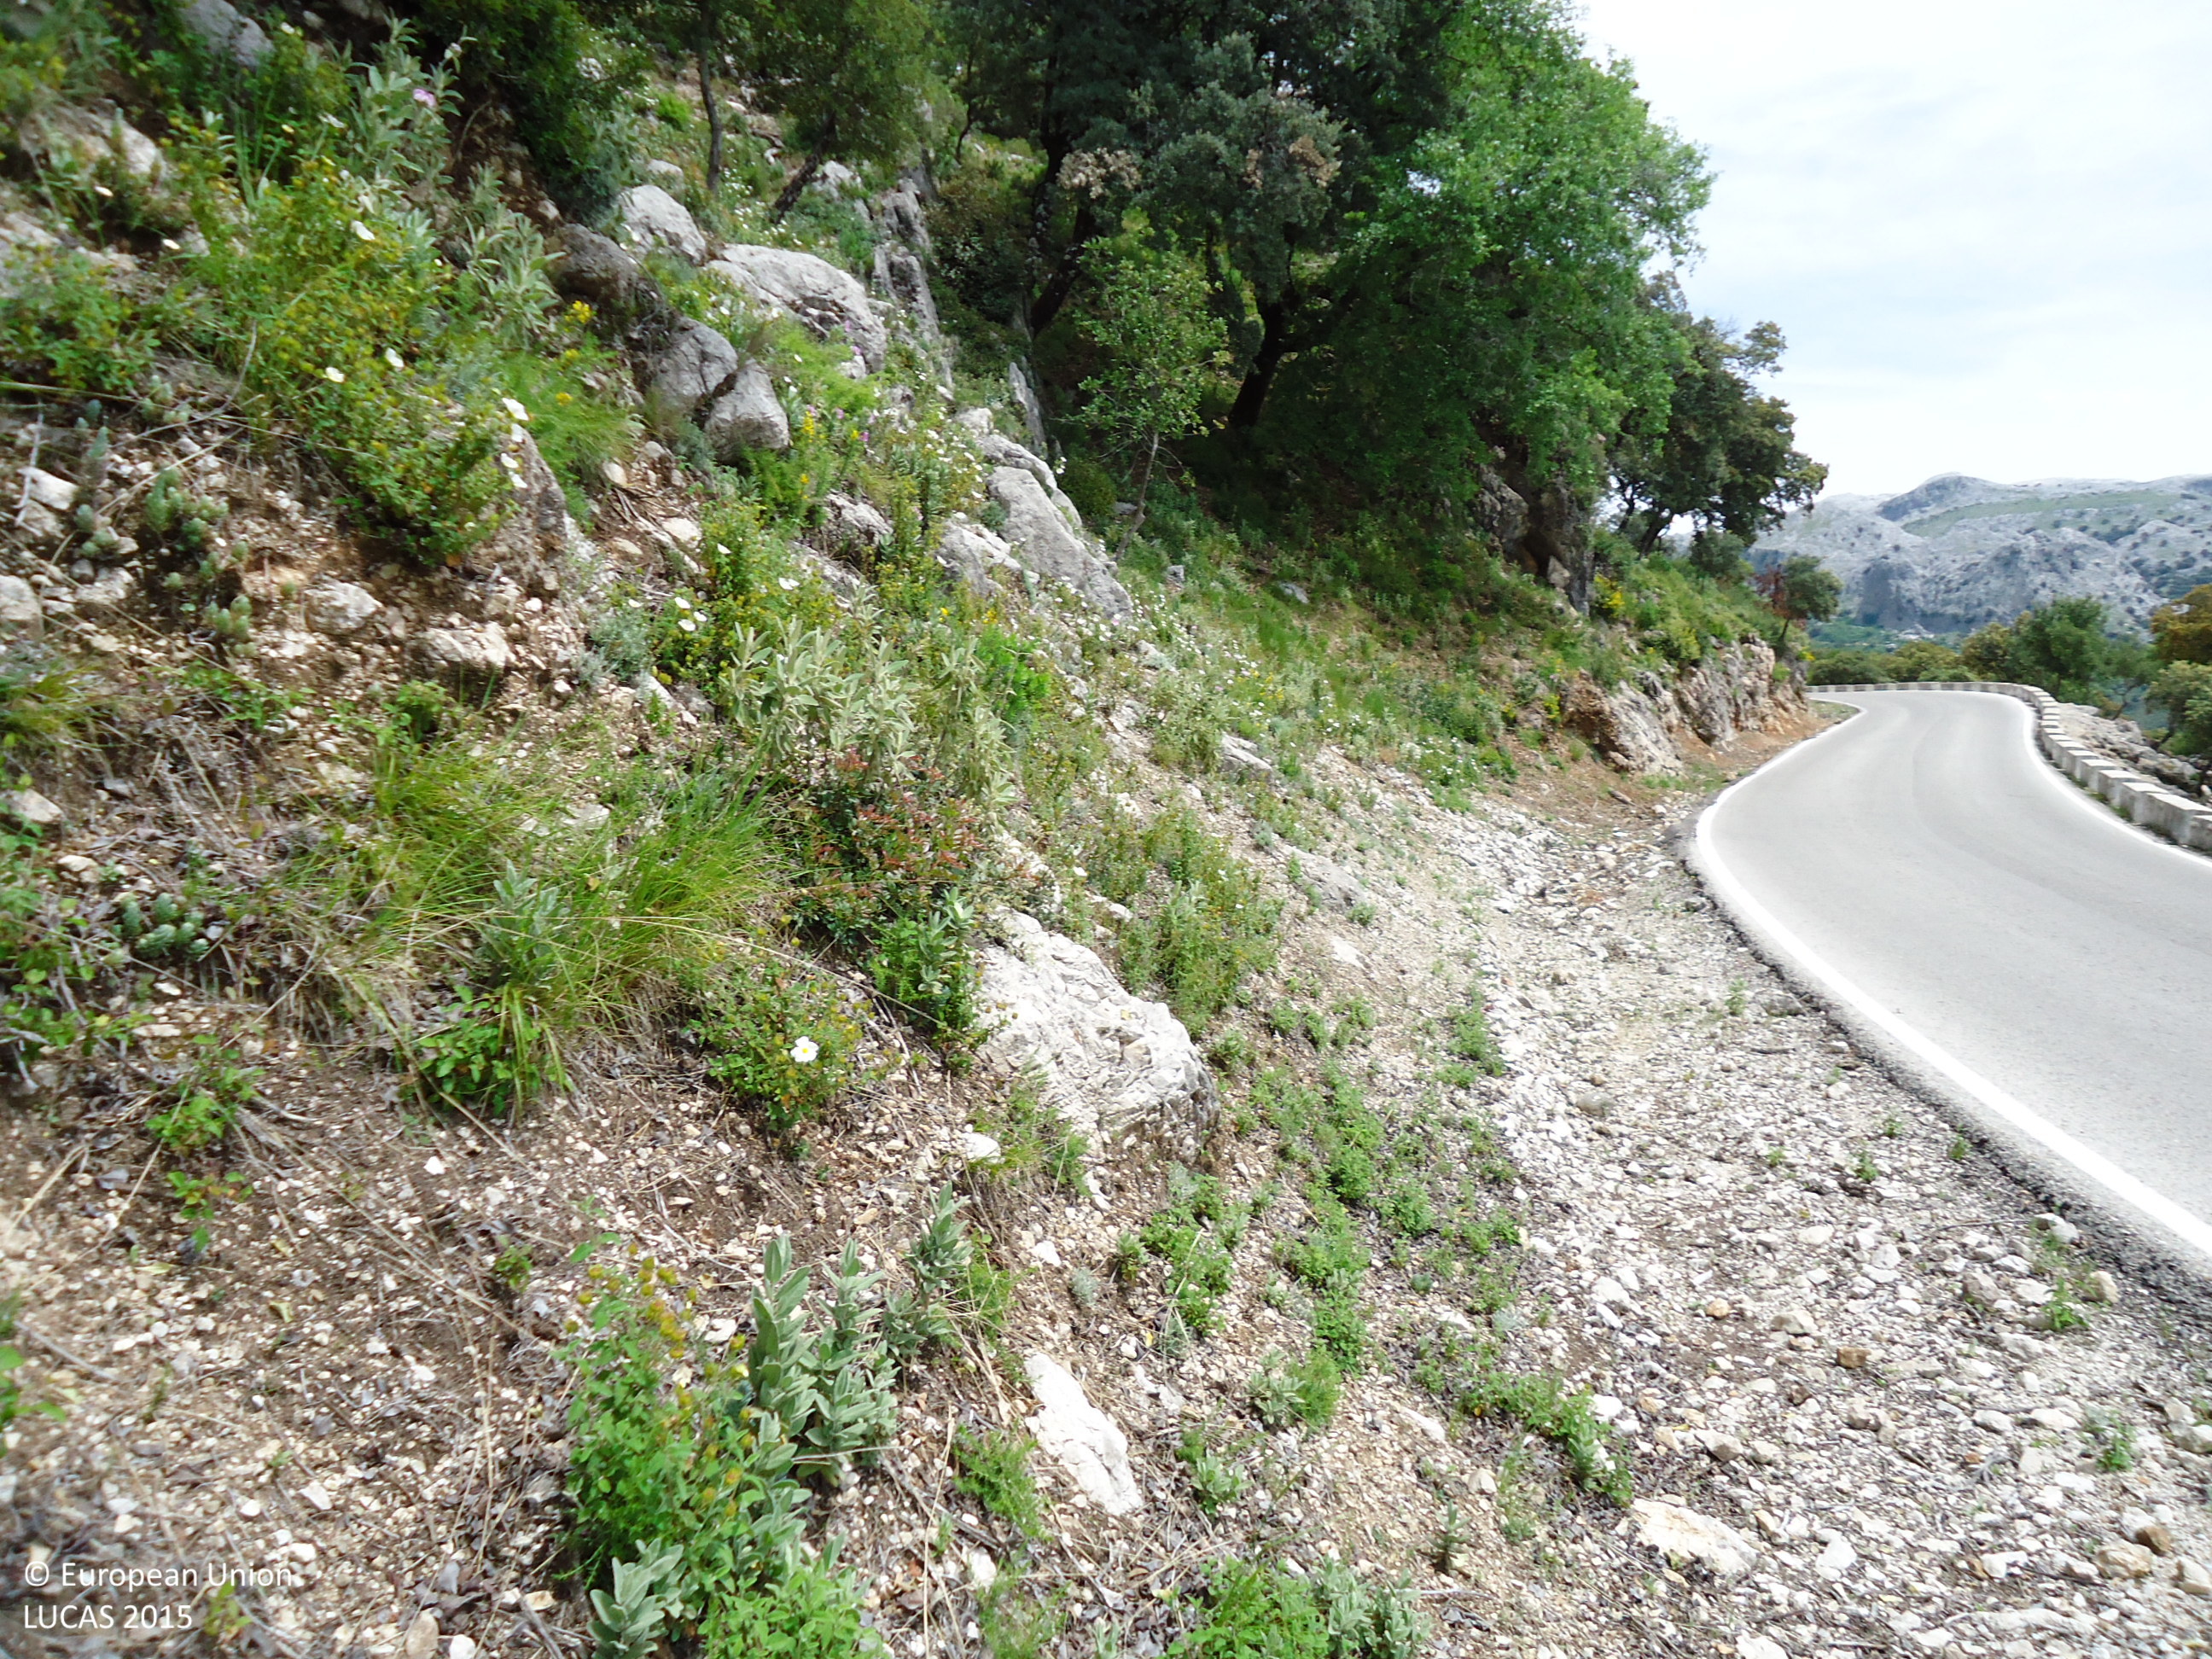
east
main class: Woodland
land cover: Broadleaved woodland
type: broadleaved evergreen forest
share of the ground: > 75 %
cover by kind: broadleaved forest trees 80 %, shrubs 10 %, coniferous forest trees 5 %, herbaceous plants 5 %
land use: Semi-natural and natural areas not in use
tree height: > 5 m
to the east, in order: Broadleaved woodland
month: May
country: ES
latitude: 36.7567
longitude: -5.4274
